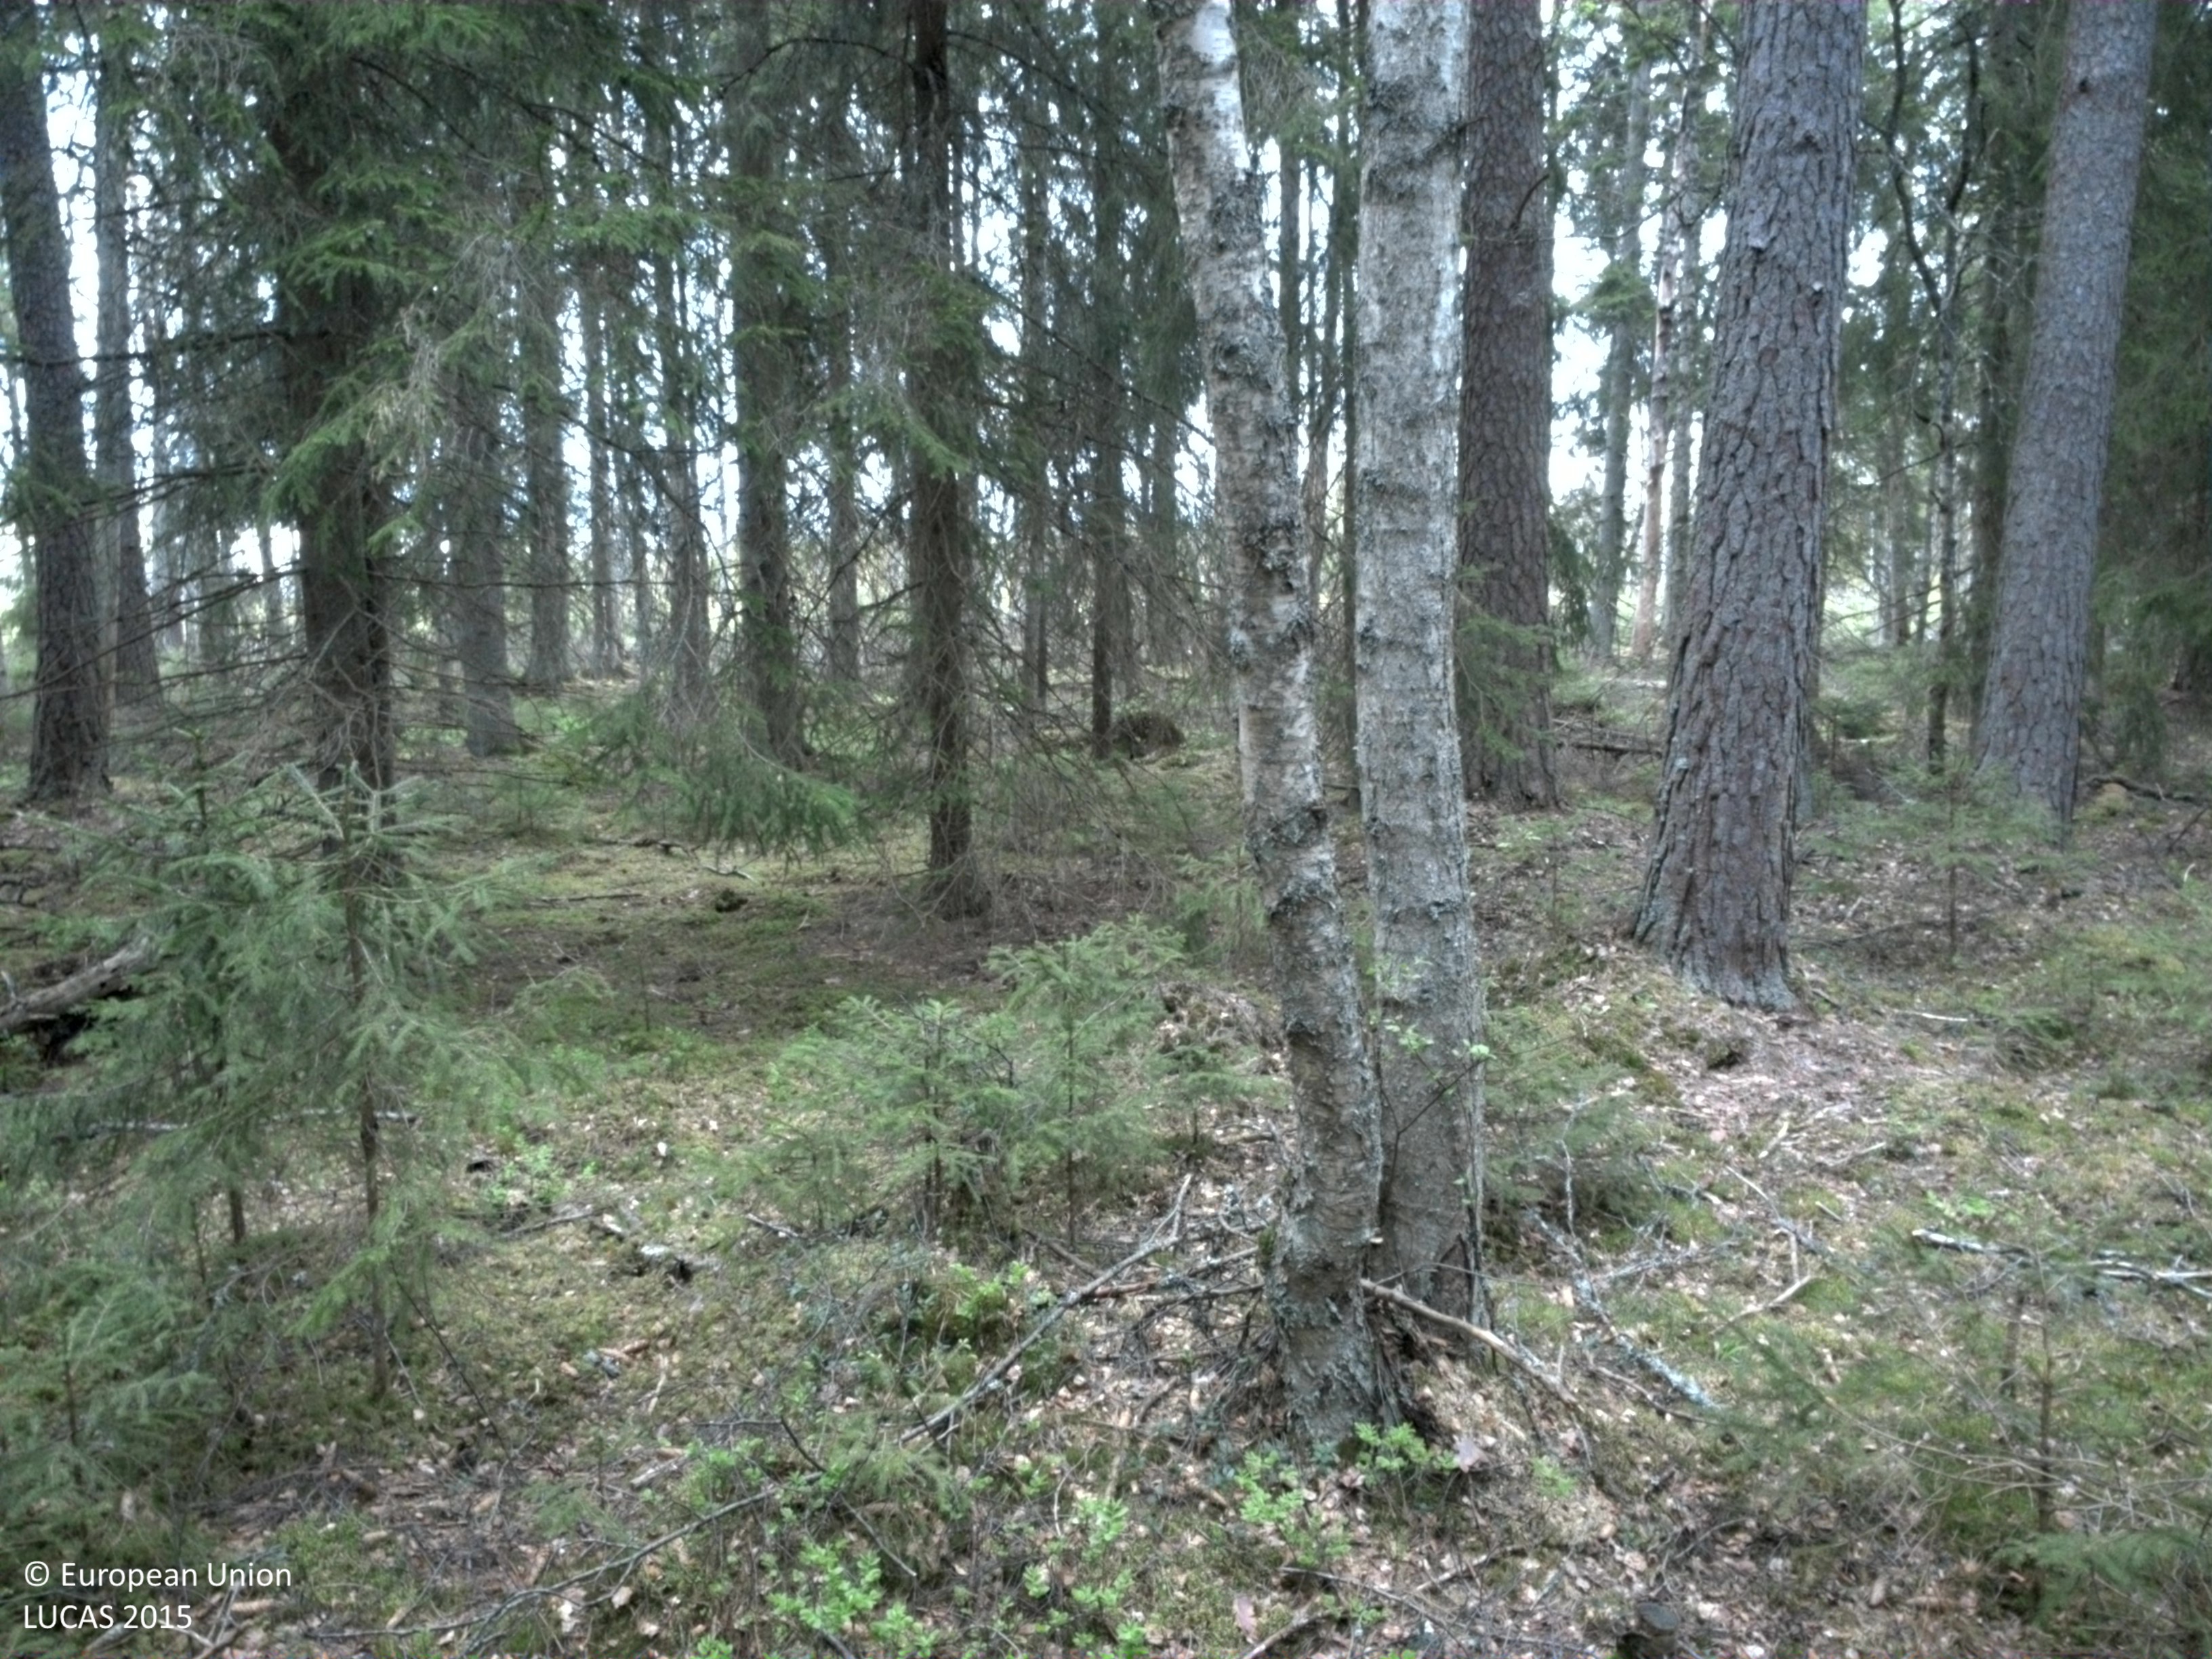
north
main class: Woodland
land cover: Spruce dominated coniferous woodland
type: boreal forest
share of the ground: 50 - 75 %
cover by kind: coniferous forest trees 60 %, shrubs 15 %, lichens and mosses 15 %, broadleaved forest trees 10 %
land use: Forestry
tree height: > 5 m
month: May
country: SE
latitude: 57.0047
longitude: 15.1178
